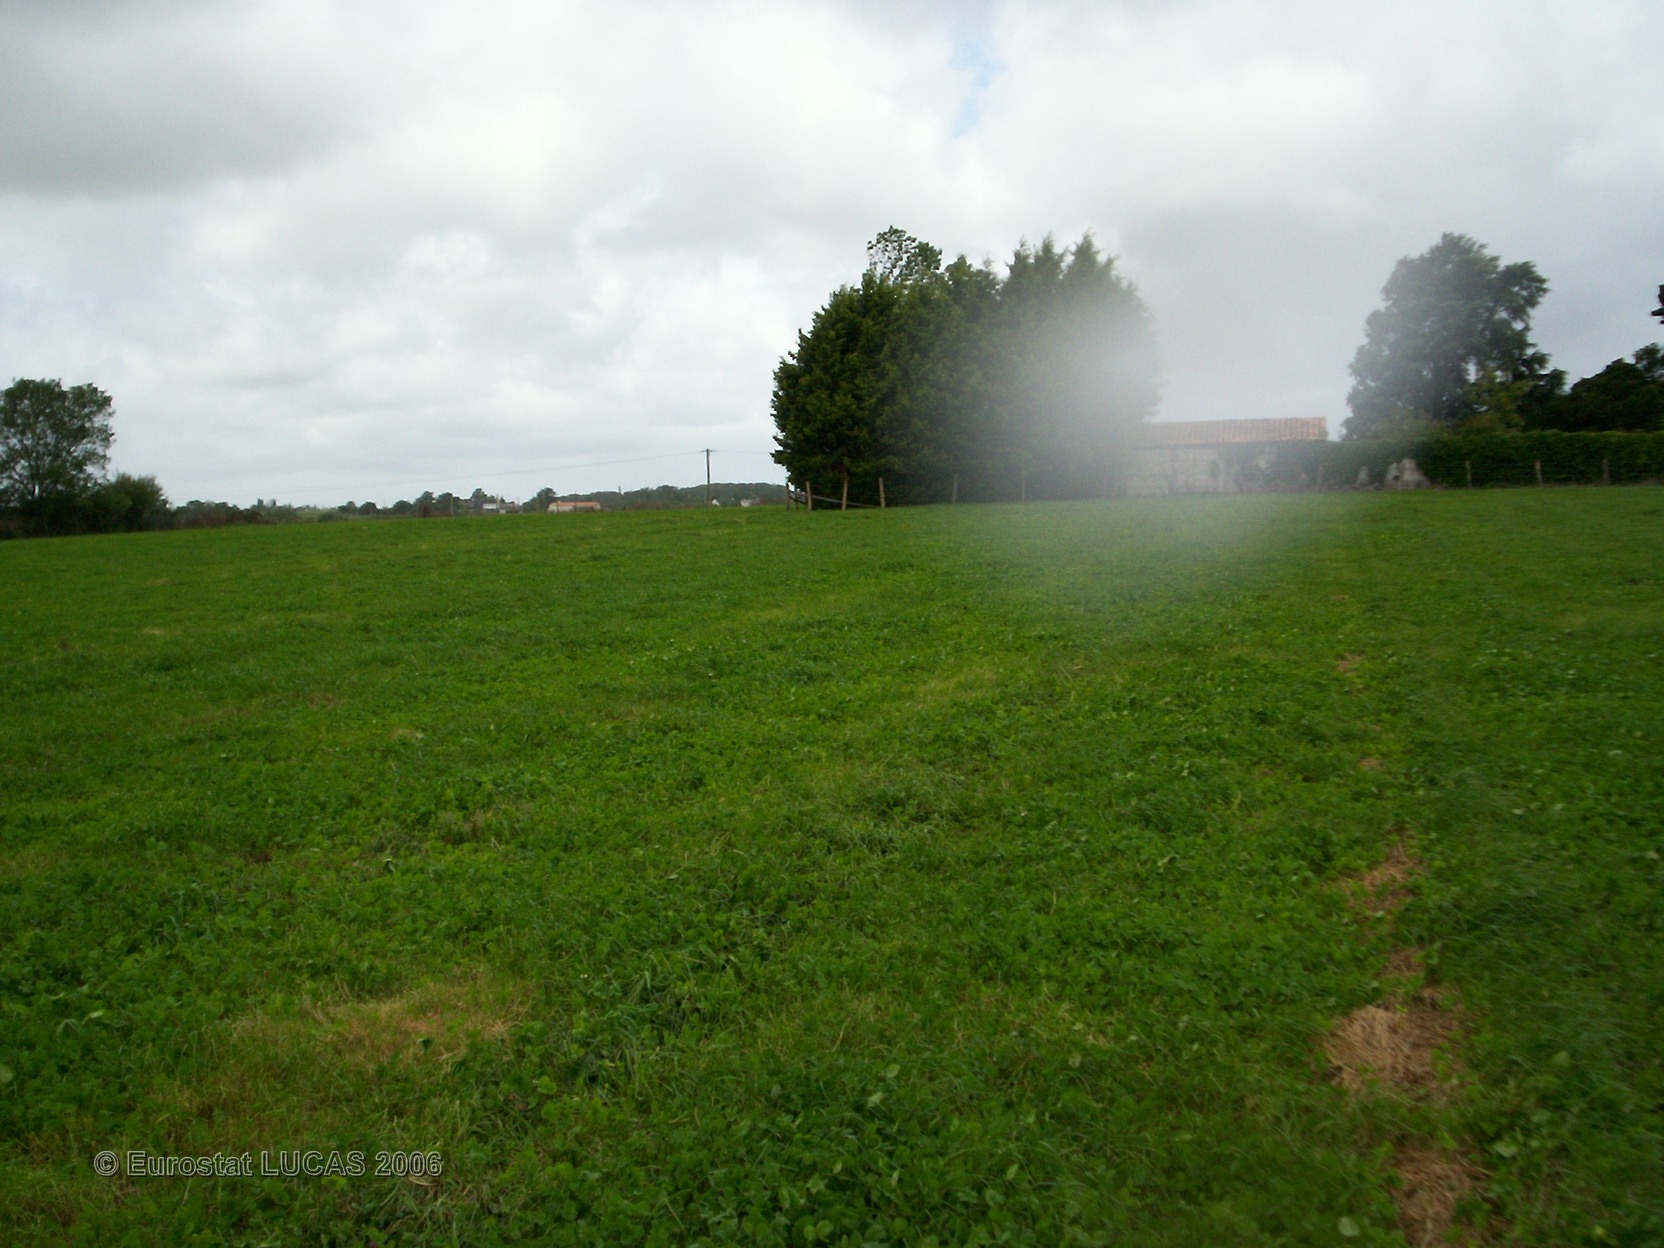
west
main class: Grassland
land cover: Grassland without tree/shrub cover
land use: Agriculture (excluding fallow land and kitchen gardens)
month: May
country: FR
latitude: 47.3355
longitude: -1.4357
